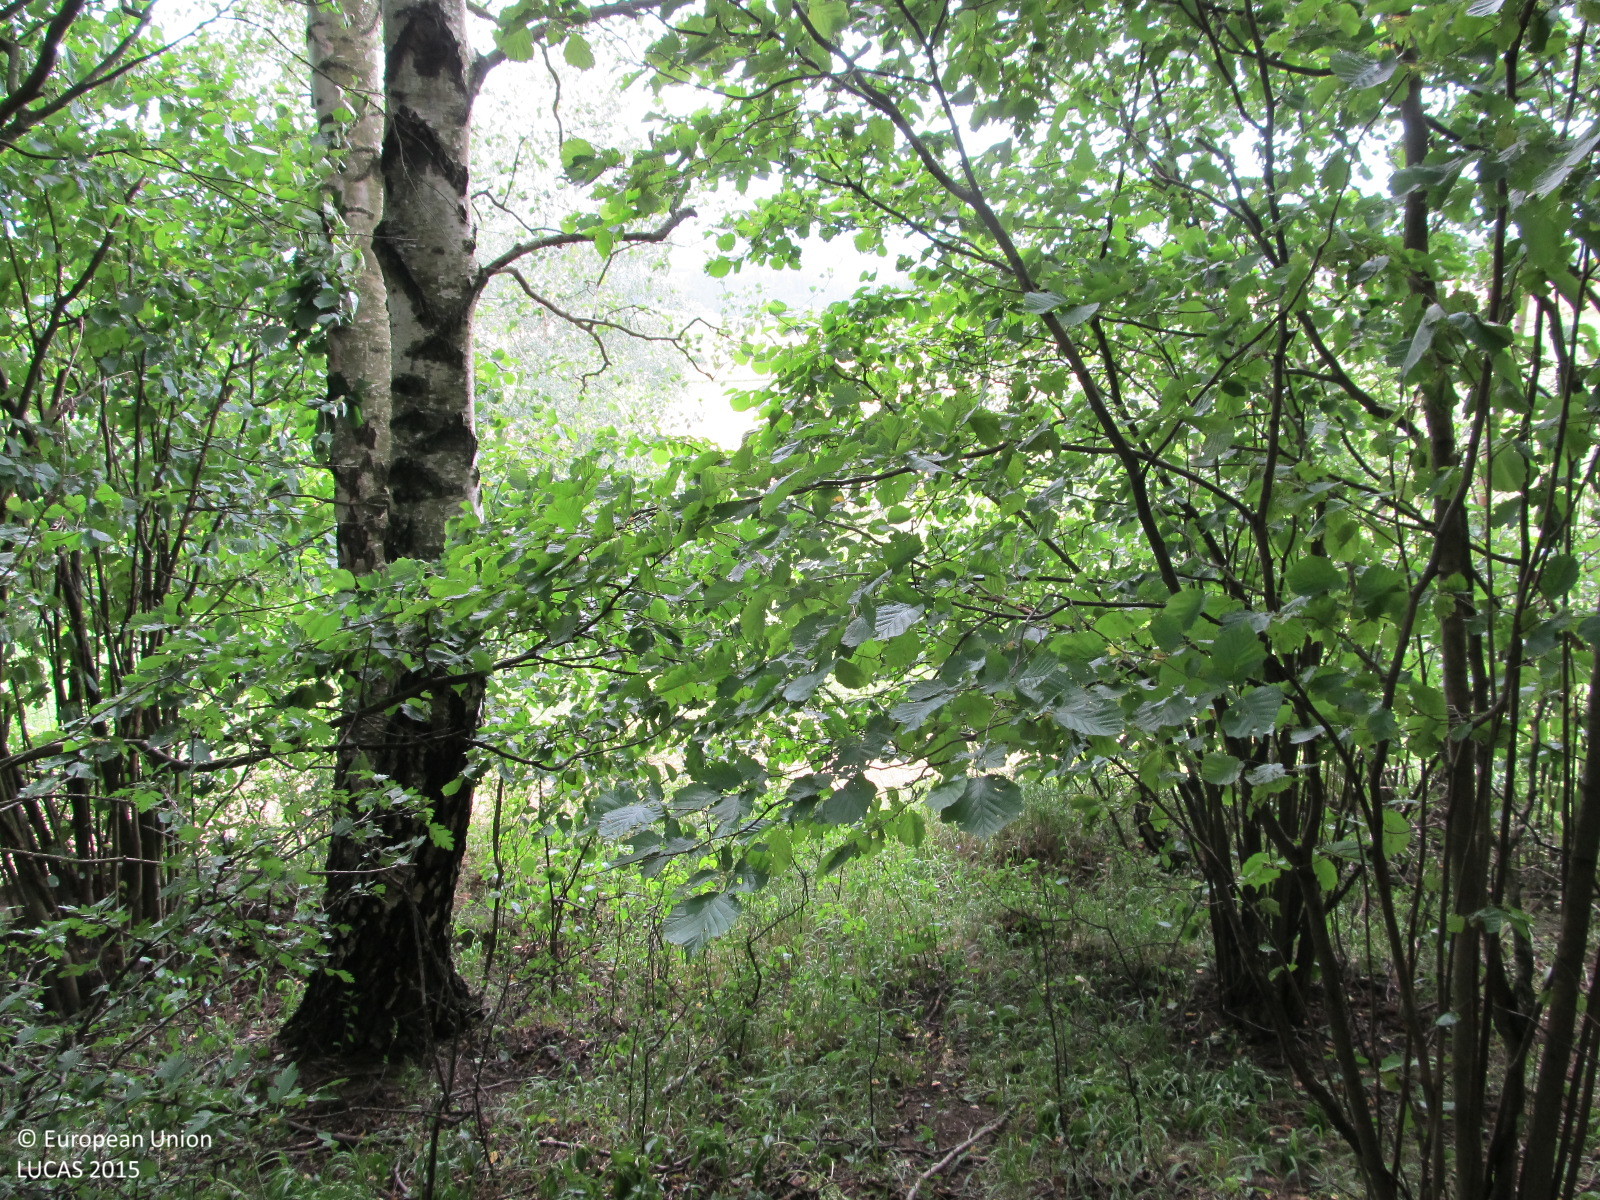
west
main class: Woodland
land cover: Broadleaved woodland
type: non-riverine alder, birch or aspen forest
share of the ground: > 75 %
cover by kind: broadleaved forest trees 75 %, herbaceous plants 15 %, shrubs 5 %, unconsolidated bare surface 5 %
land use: Forestry
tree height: < 5 m
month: July
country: AT
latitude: 48.4328
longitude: 15.4223
